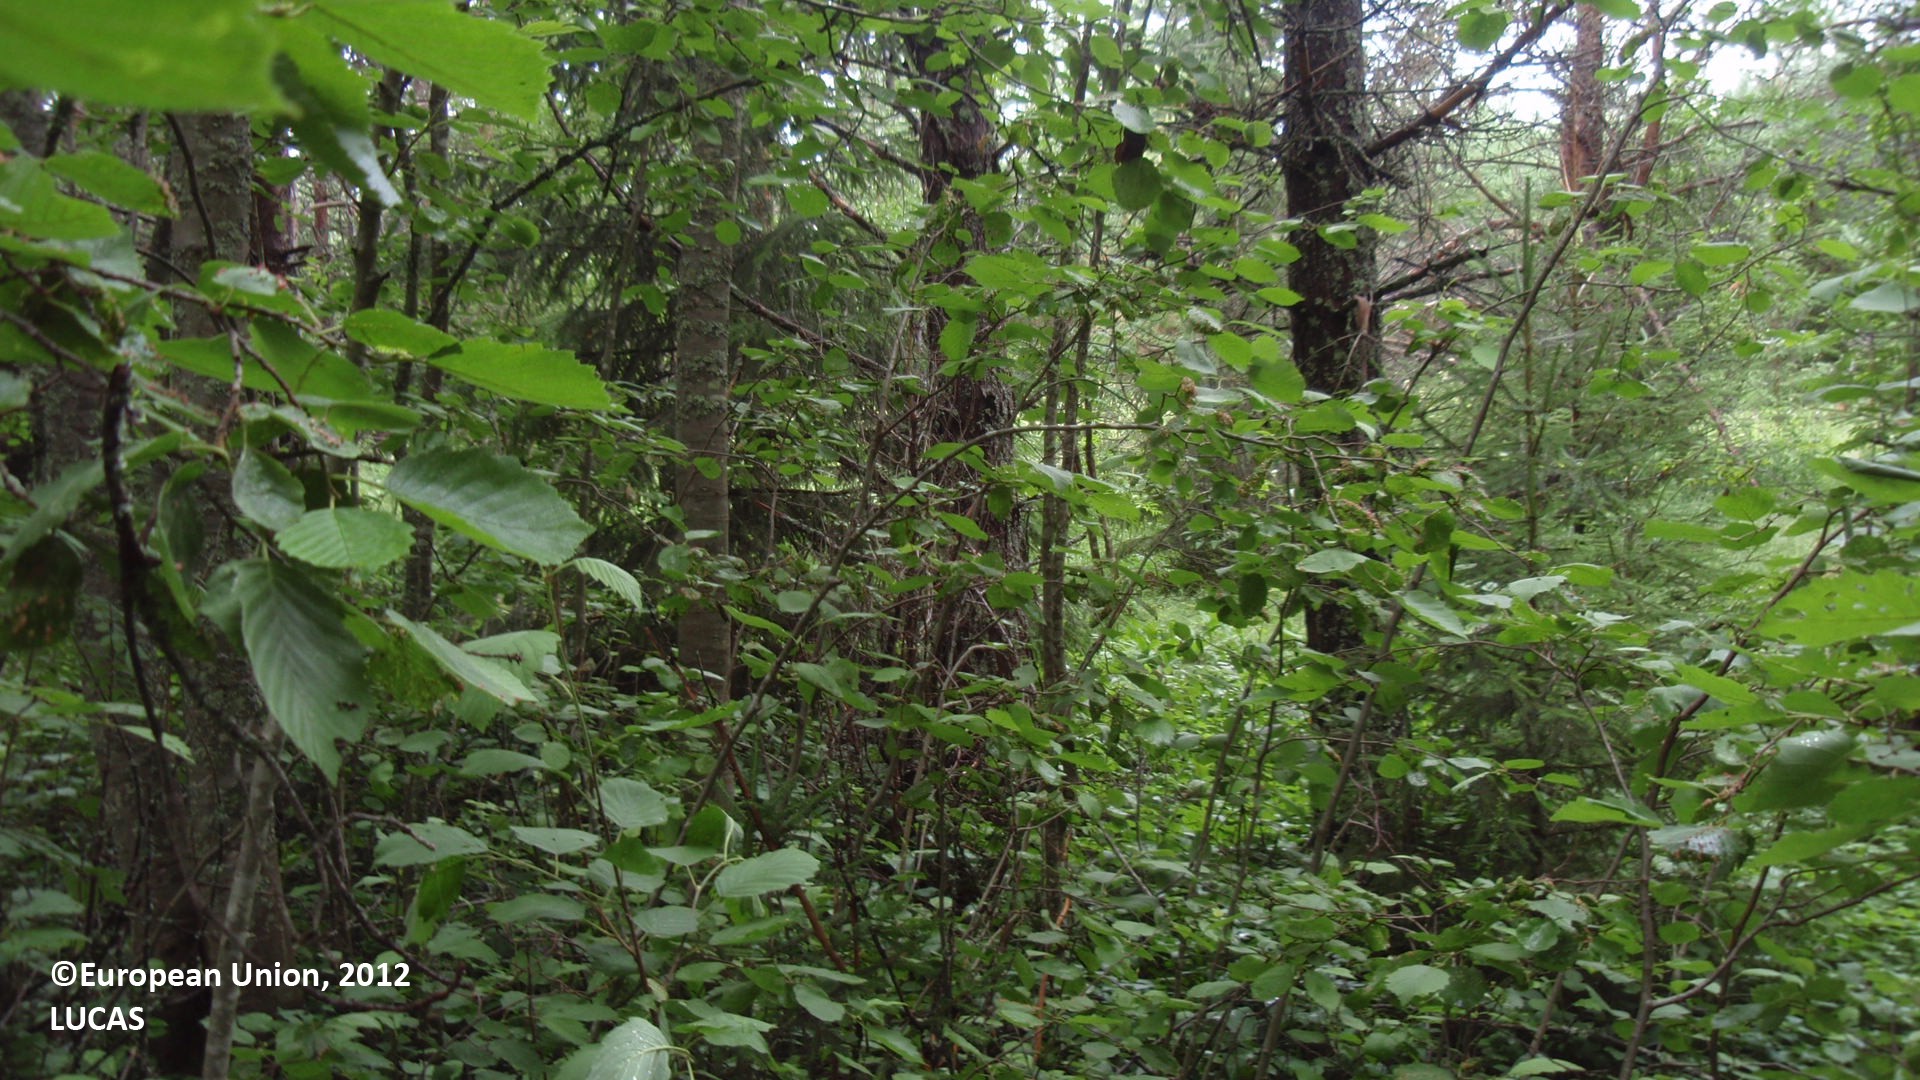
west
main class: Woodland
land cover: Pine dominated mixed woodland
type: boreal forest
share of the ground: > 75 %
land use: Forestry
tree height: > 5 m
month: July
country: FI
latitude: 61.4763
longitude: 26.9237
